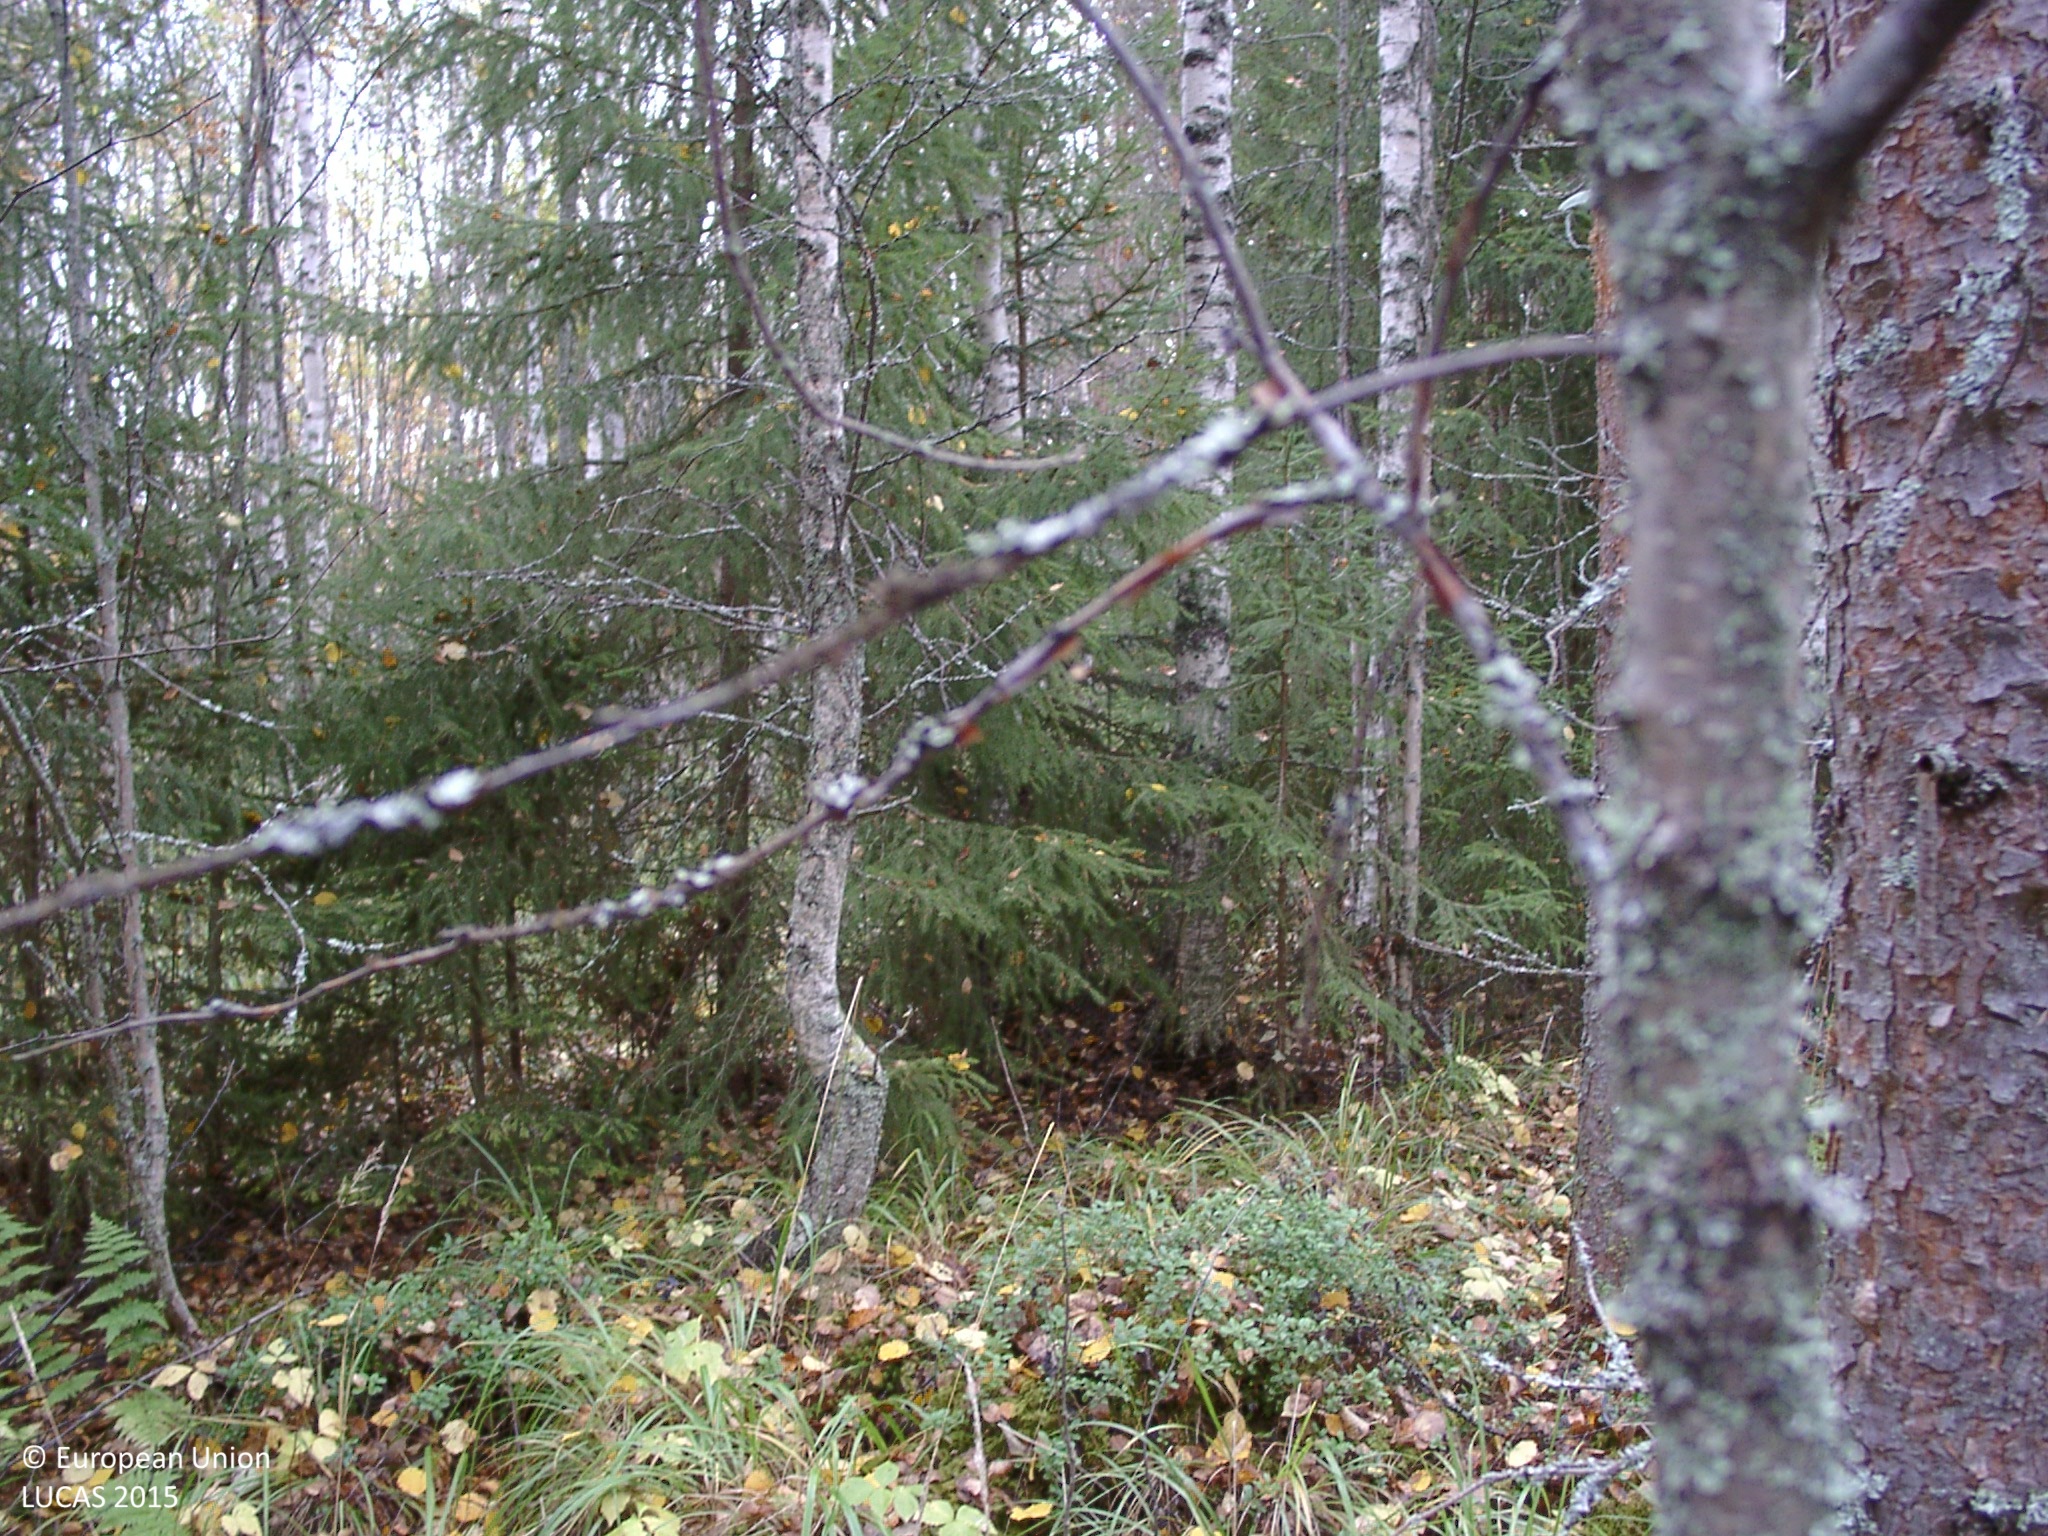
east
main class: Woodland
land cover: Other mixed woodland
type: boreal forest
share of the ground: > 75 %
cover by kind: broadleaved forest trees 55 %, coniferous forest trees 25 %, herbaceous plants 15 %, lichens and mosses 5 %
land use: Forestry
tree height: > 5 m
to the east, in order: Other mixed woodland; Pine dominated mixed woodland; Broadleaved woodland; Pine dominated mixed woodland; Electric lines; Pine dominated mixed woodland; Pine dominated coniferous woodland; Tracks; Grass margins; Ditches and canals; Electric lines; Other coniferous woodland; Pine dominated coniferous woodland
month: September
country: FI
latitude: 62.5279
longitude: 25.4409
